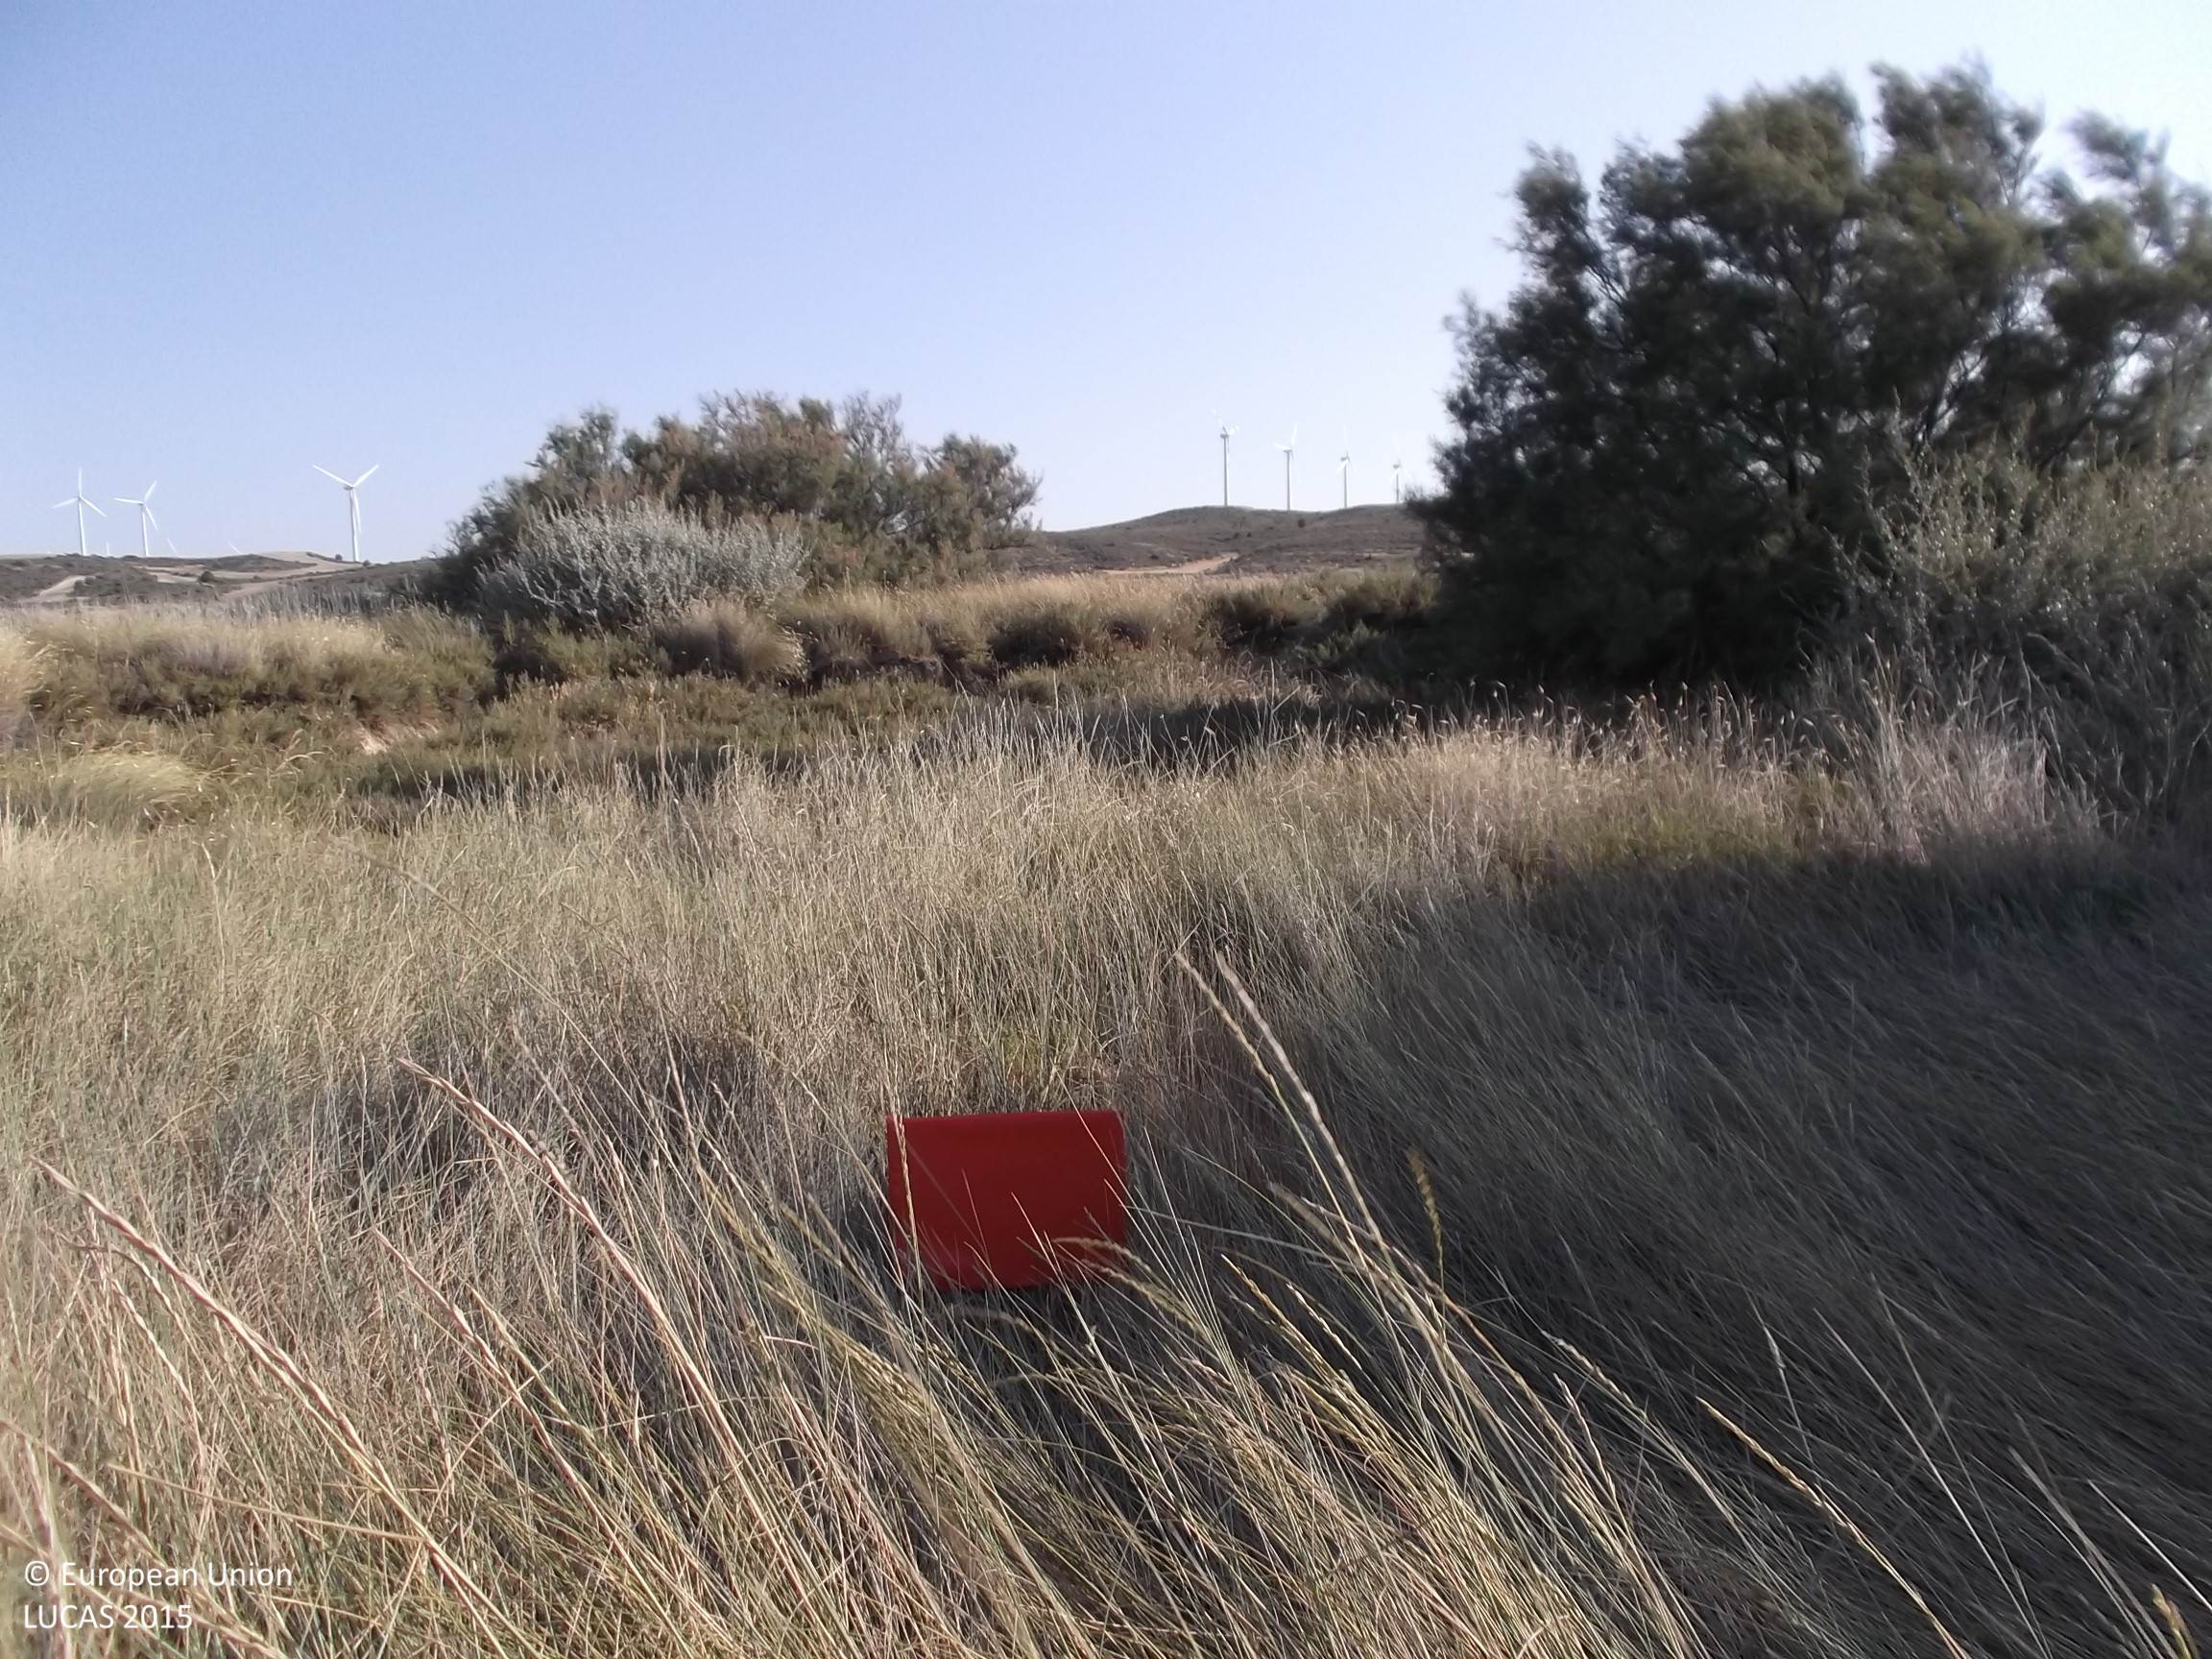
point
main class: Grassland
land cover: Grassland without tree/shrub cover
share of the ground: > 75 %
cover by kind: herbaceous plants 95 %
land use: Semi-natural and natural areas not in use
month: July
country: ES
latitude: 42.3109
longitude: -1.6204
